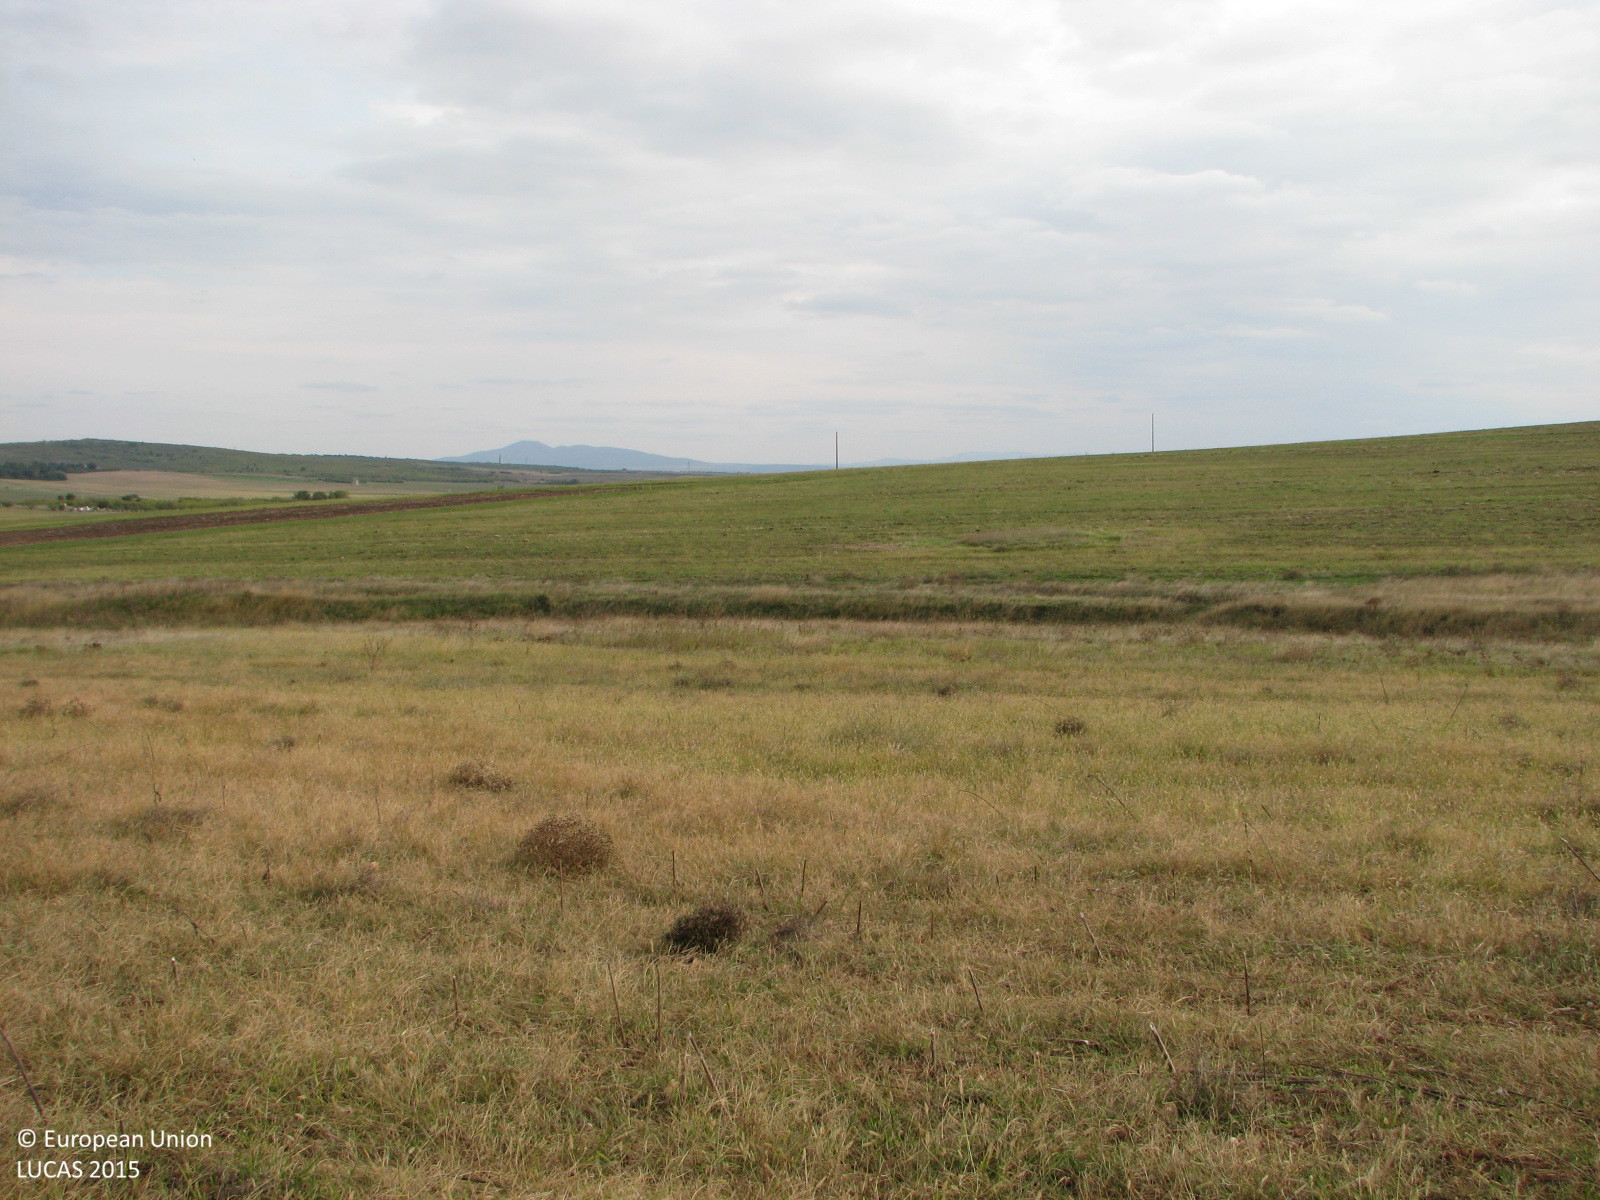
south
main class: Grassland
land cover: Spontaneously vegetated surfaces
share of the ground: > 75 %
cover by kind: herbaceous plants 100 %
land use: Agriculture (excluding fallow land and kitchen gardens)
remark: Harvested field
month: October
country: BG
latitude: 42.4047
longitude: 26.2074
